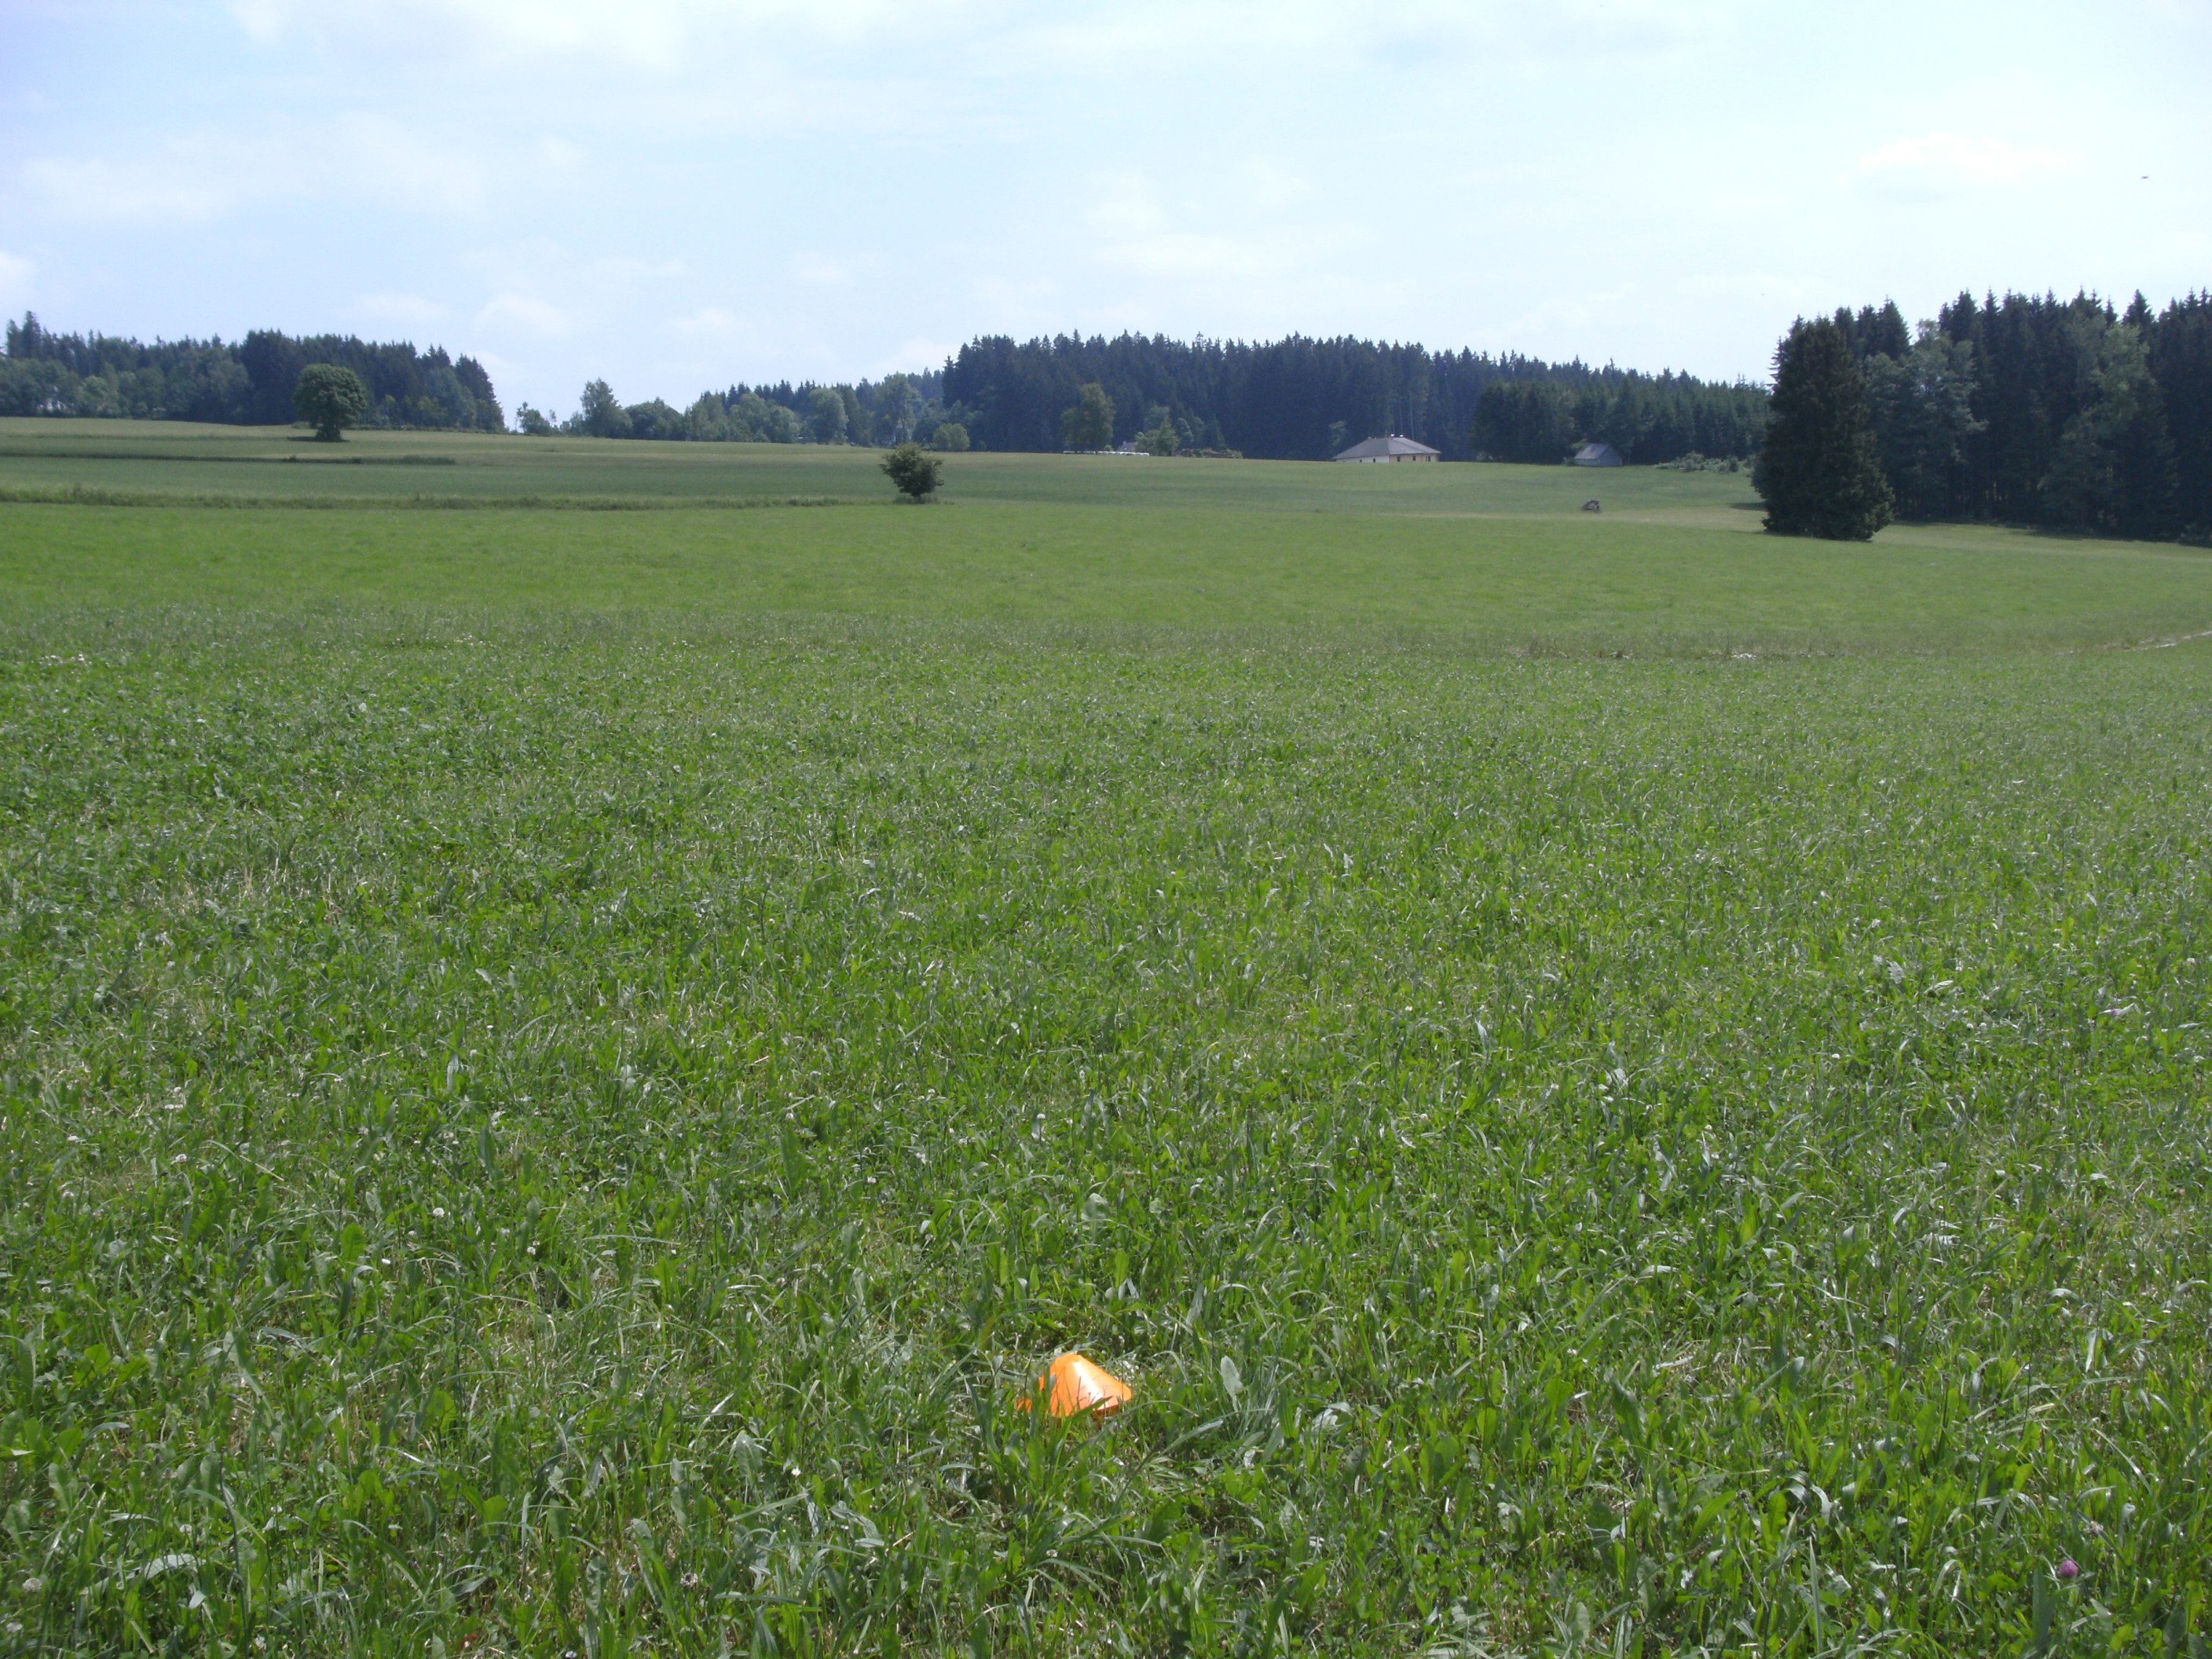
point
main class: Grassland
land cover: Grassland without tree/shrub cover
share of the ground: > 75 %
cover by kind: herbaceous plants 100 %
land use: Agriculture (excluding fallow land and kitchen gardens)
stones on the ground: < 10 %
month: June
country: AT
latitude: 48.5395
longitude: 14.2126
